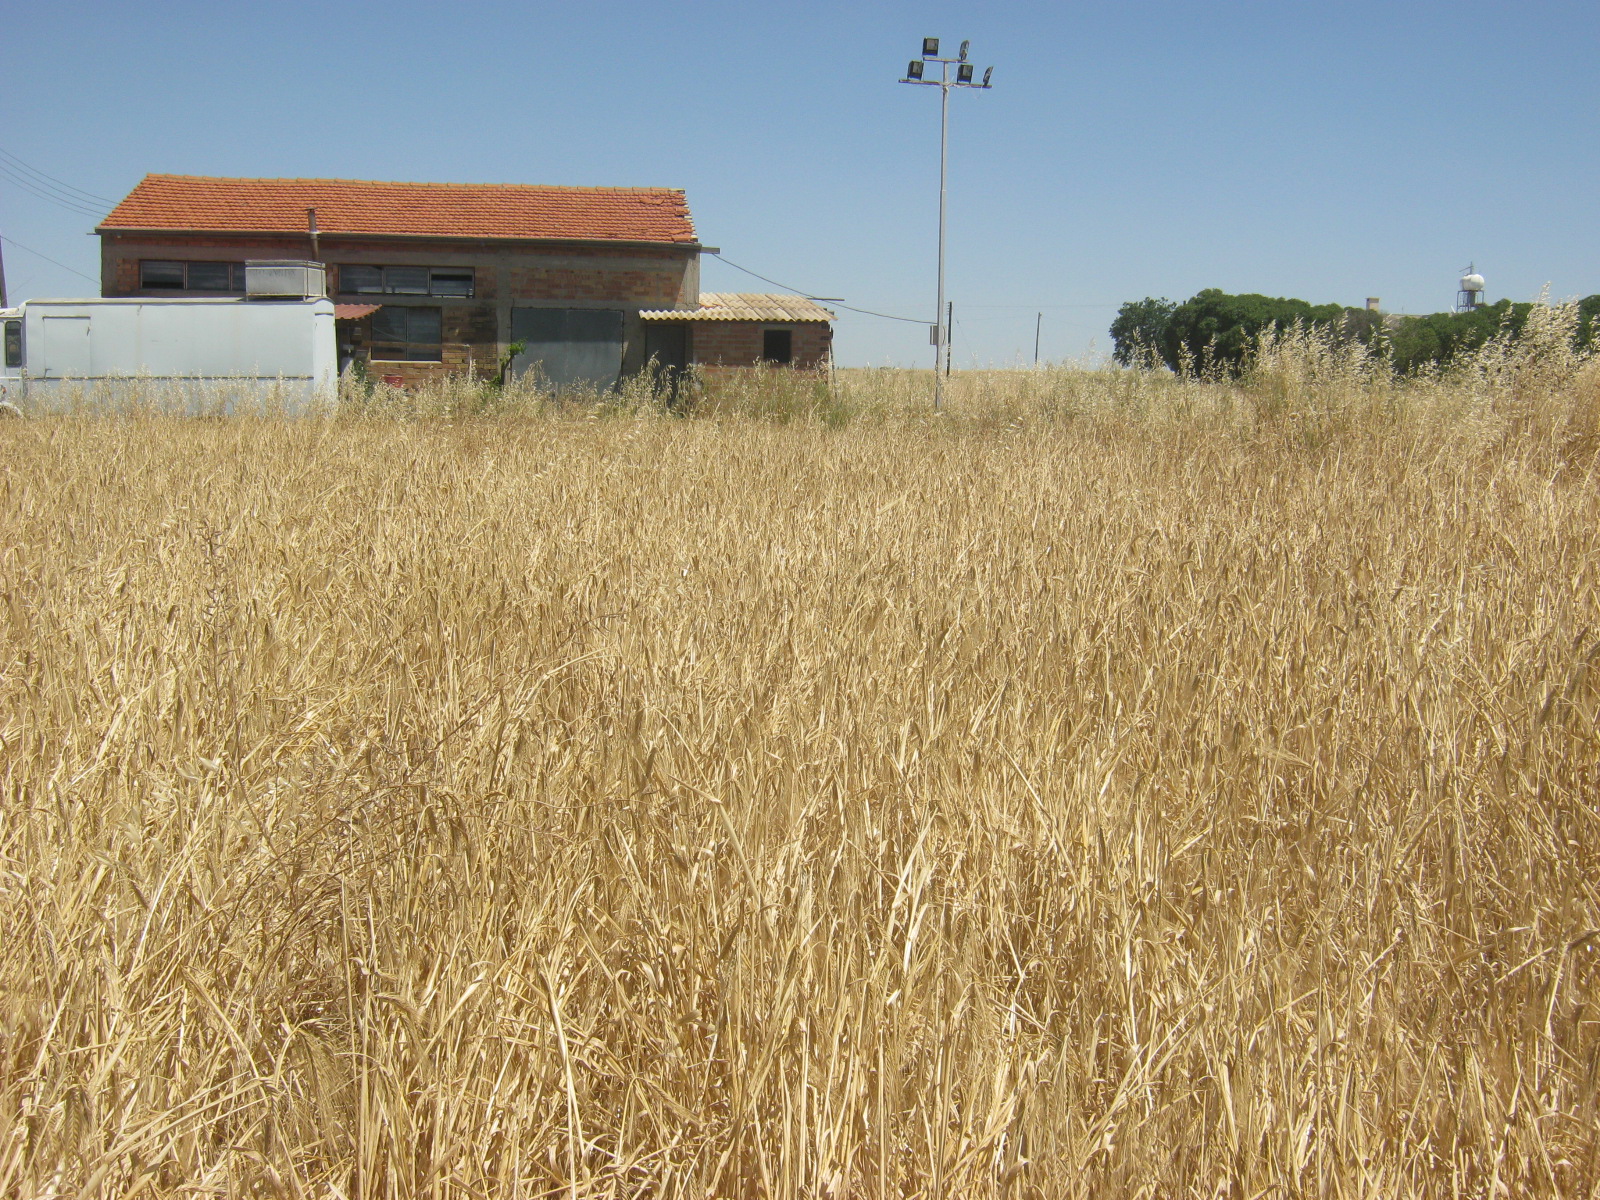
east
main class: Cropland
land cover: Barley
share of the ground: > 75 %
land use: Agriculture (excluding fallow land and kitchen gardens)
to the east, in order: Barley; Paved roads, cycling and walking lanes; Other bare soil; Artificial constructions in urban areas; Barley; Electric lines; Paved roads, cycling and walking lanes; Mixed cereals for fodder
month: May
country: CY
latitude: 35.1136
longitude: 33.2163
